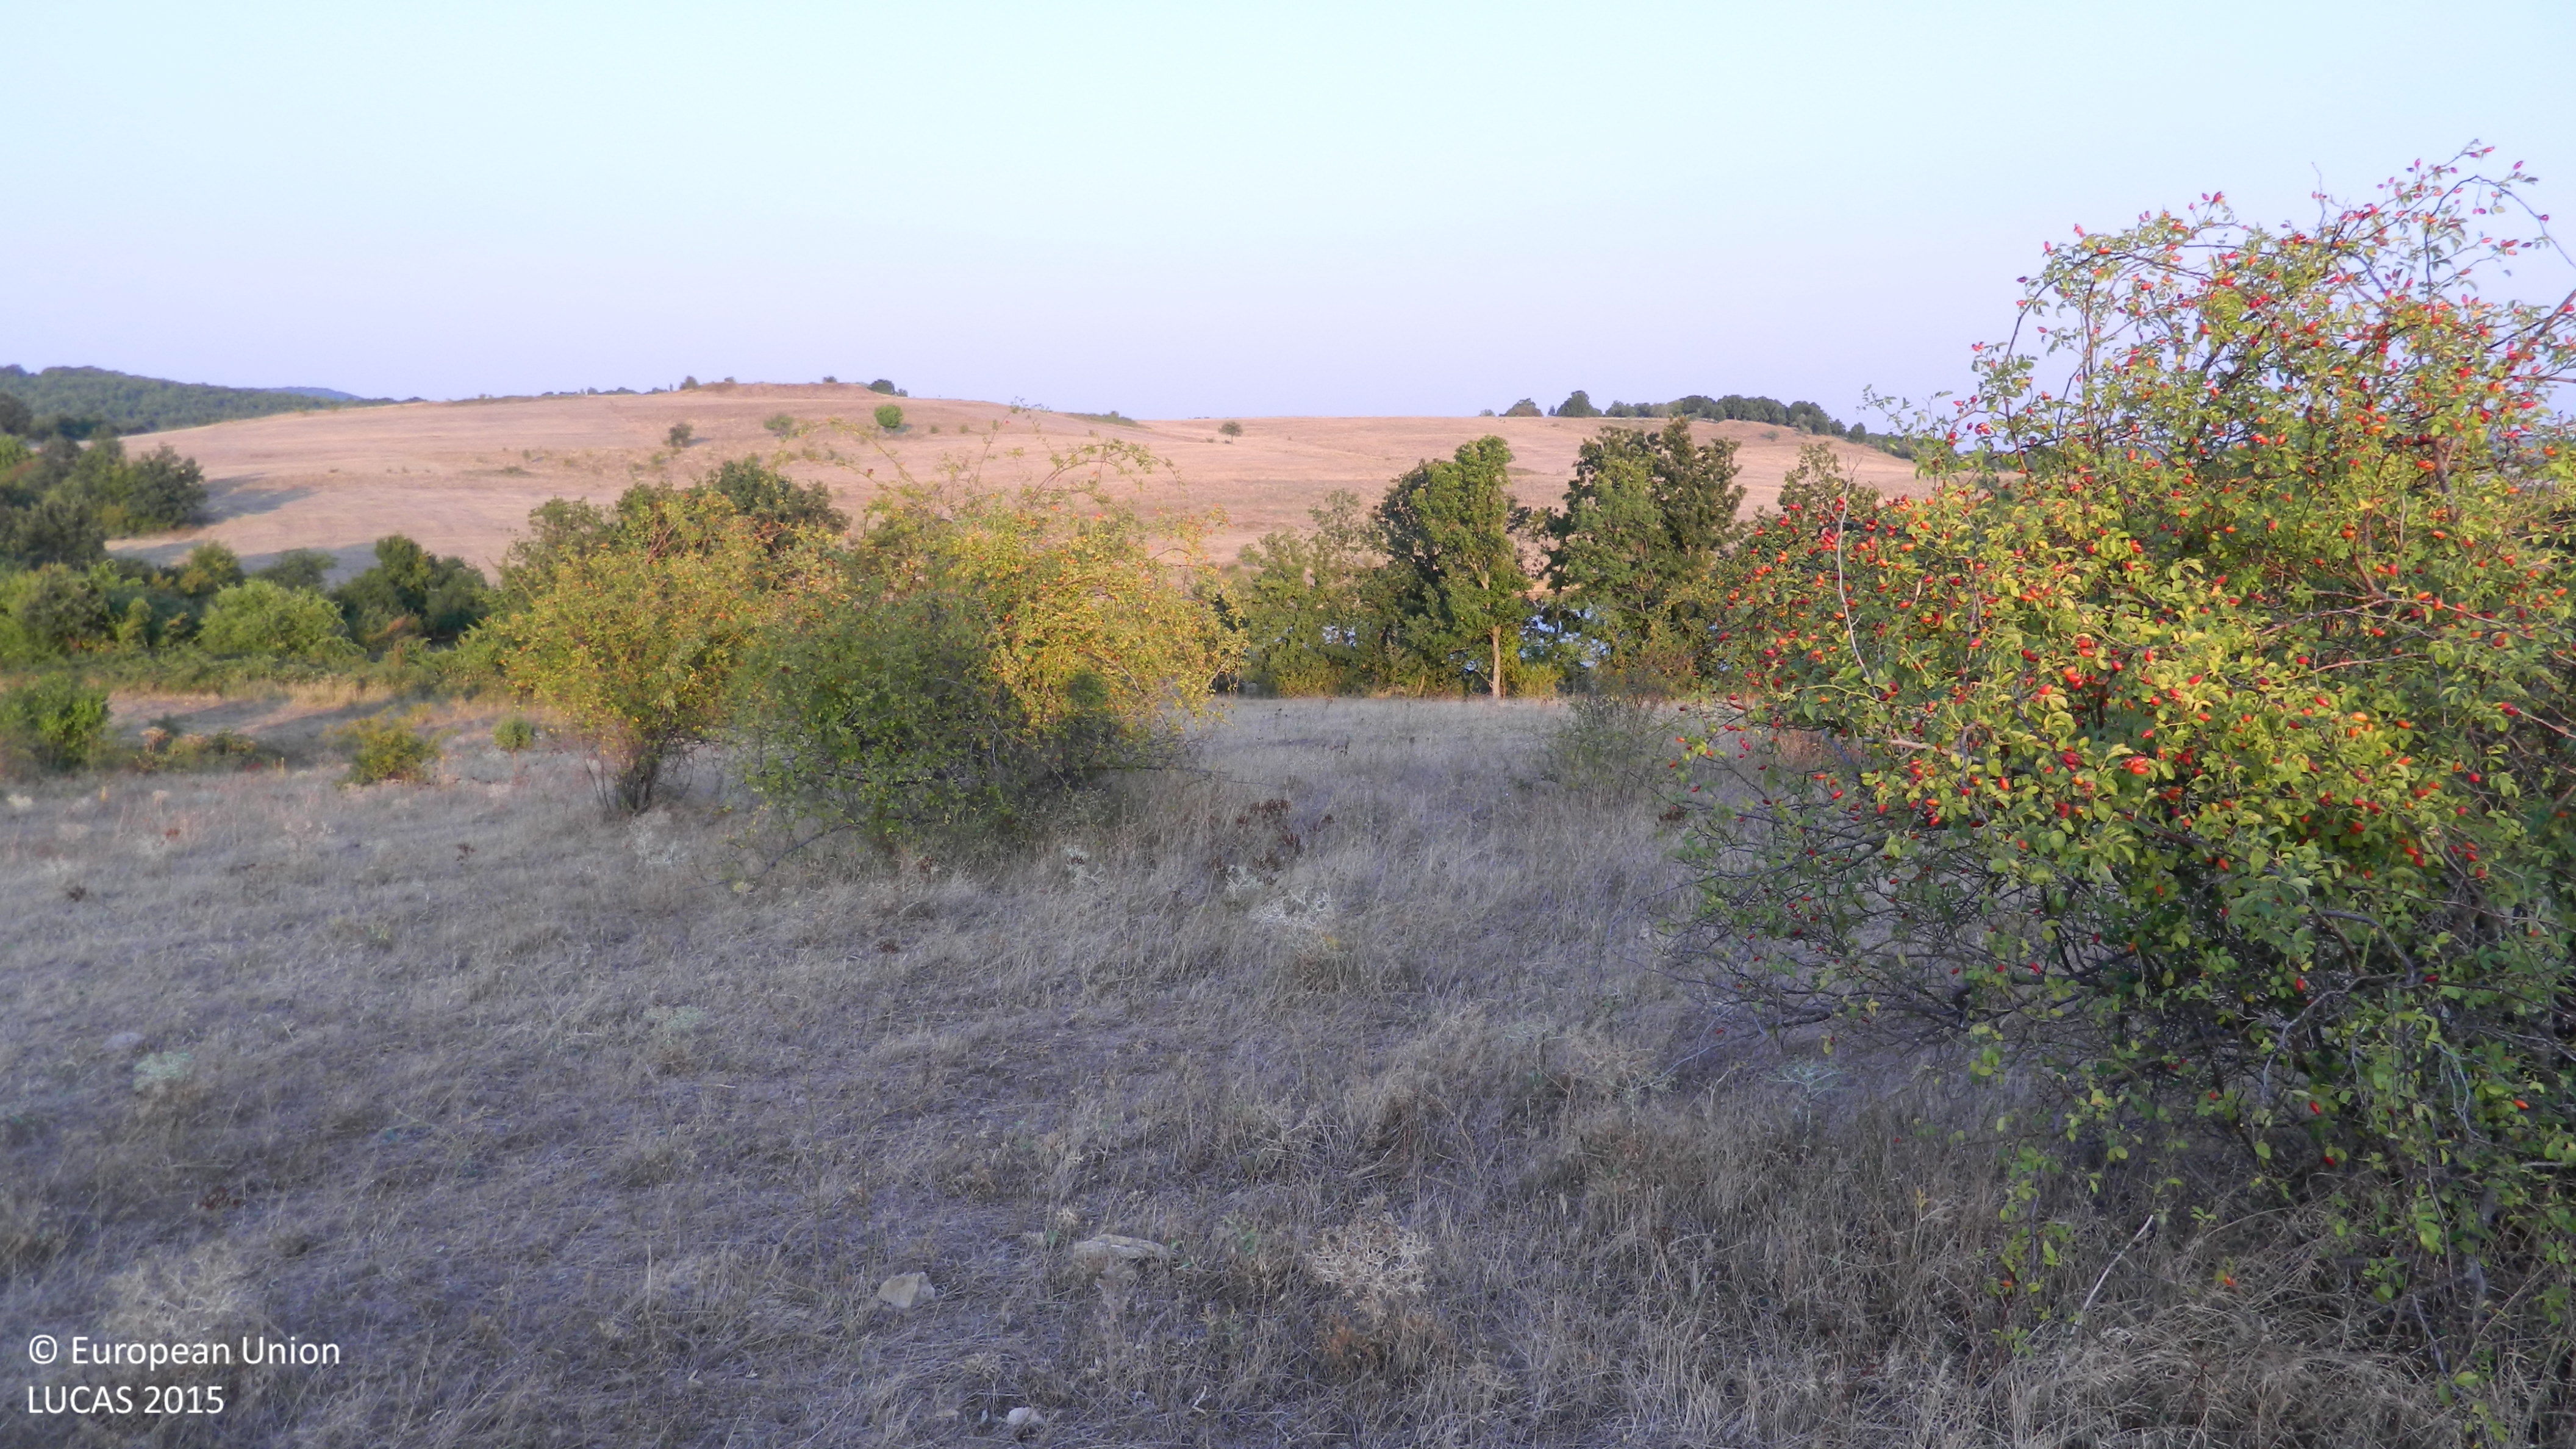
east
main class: Grassland
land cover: Grassland with sparse tree/shrub cover
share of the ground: > 75 %
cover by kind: herbaceous plants 90 %, broadleaved forest trees 5 %, shrubs 5 %
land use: Agriculture (excluding fallow land and kitchen gardens)
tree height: < 5 m
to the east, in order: Grassland with sparse tree/shrub cover; Grassland without tree/shrub cover; Tracks; Shrubland with sparse tree cover; Grassland without tree/shrub cover; Tracks; Shruby margins; Grassland without tree/shrub cover; Tracks; Grassland without tree/shrub cover
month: August
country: BG
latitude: 41.4967
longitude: 25.9139
